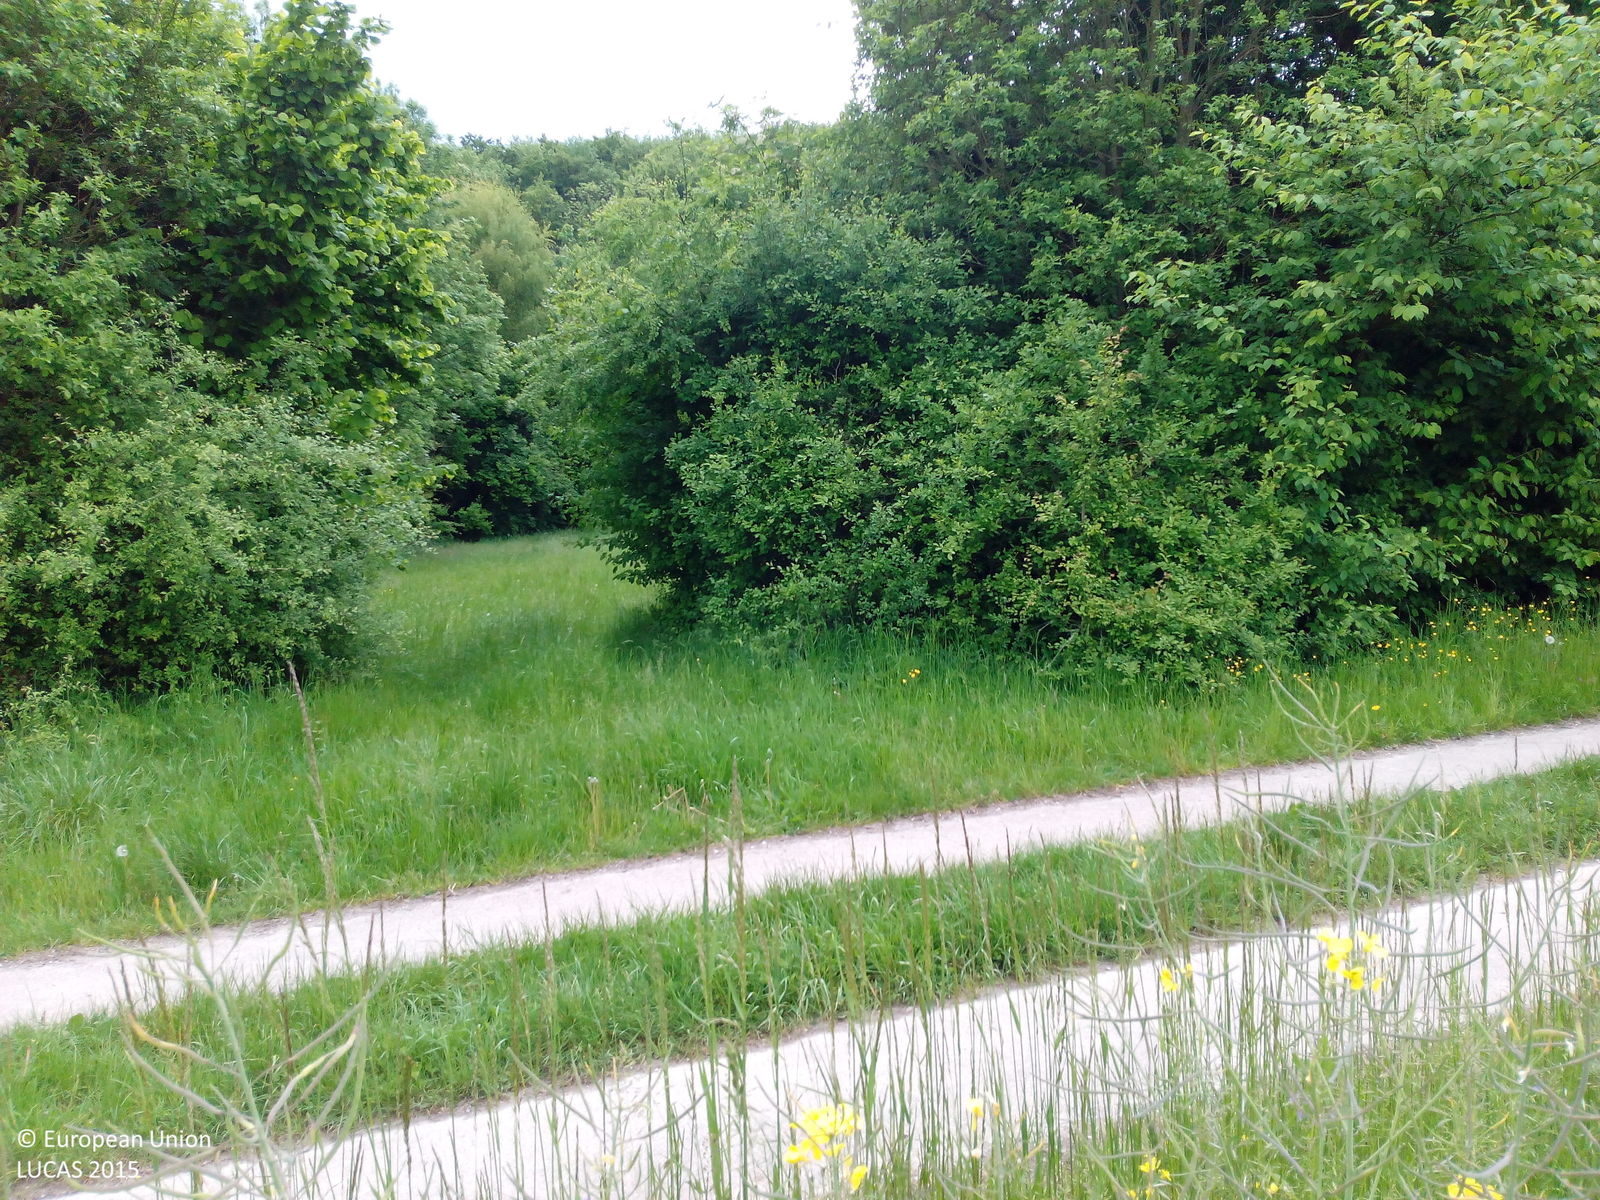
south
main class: Cropland
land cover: Rape and turnip rape
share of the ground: > 75 %
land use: Agriculture (excluding fallow land and kitchen gardens)
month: May
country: DE
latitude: 52.0359
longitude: 9.8980
